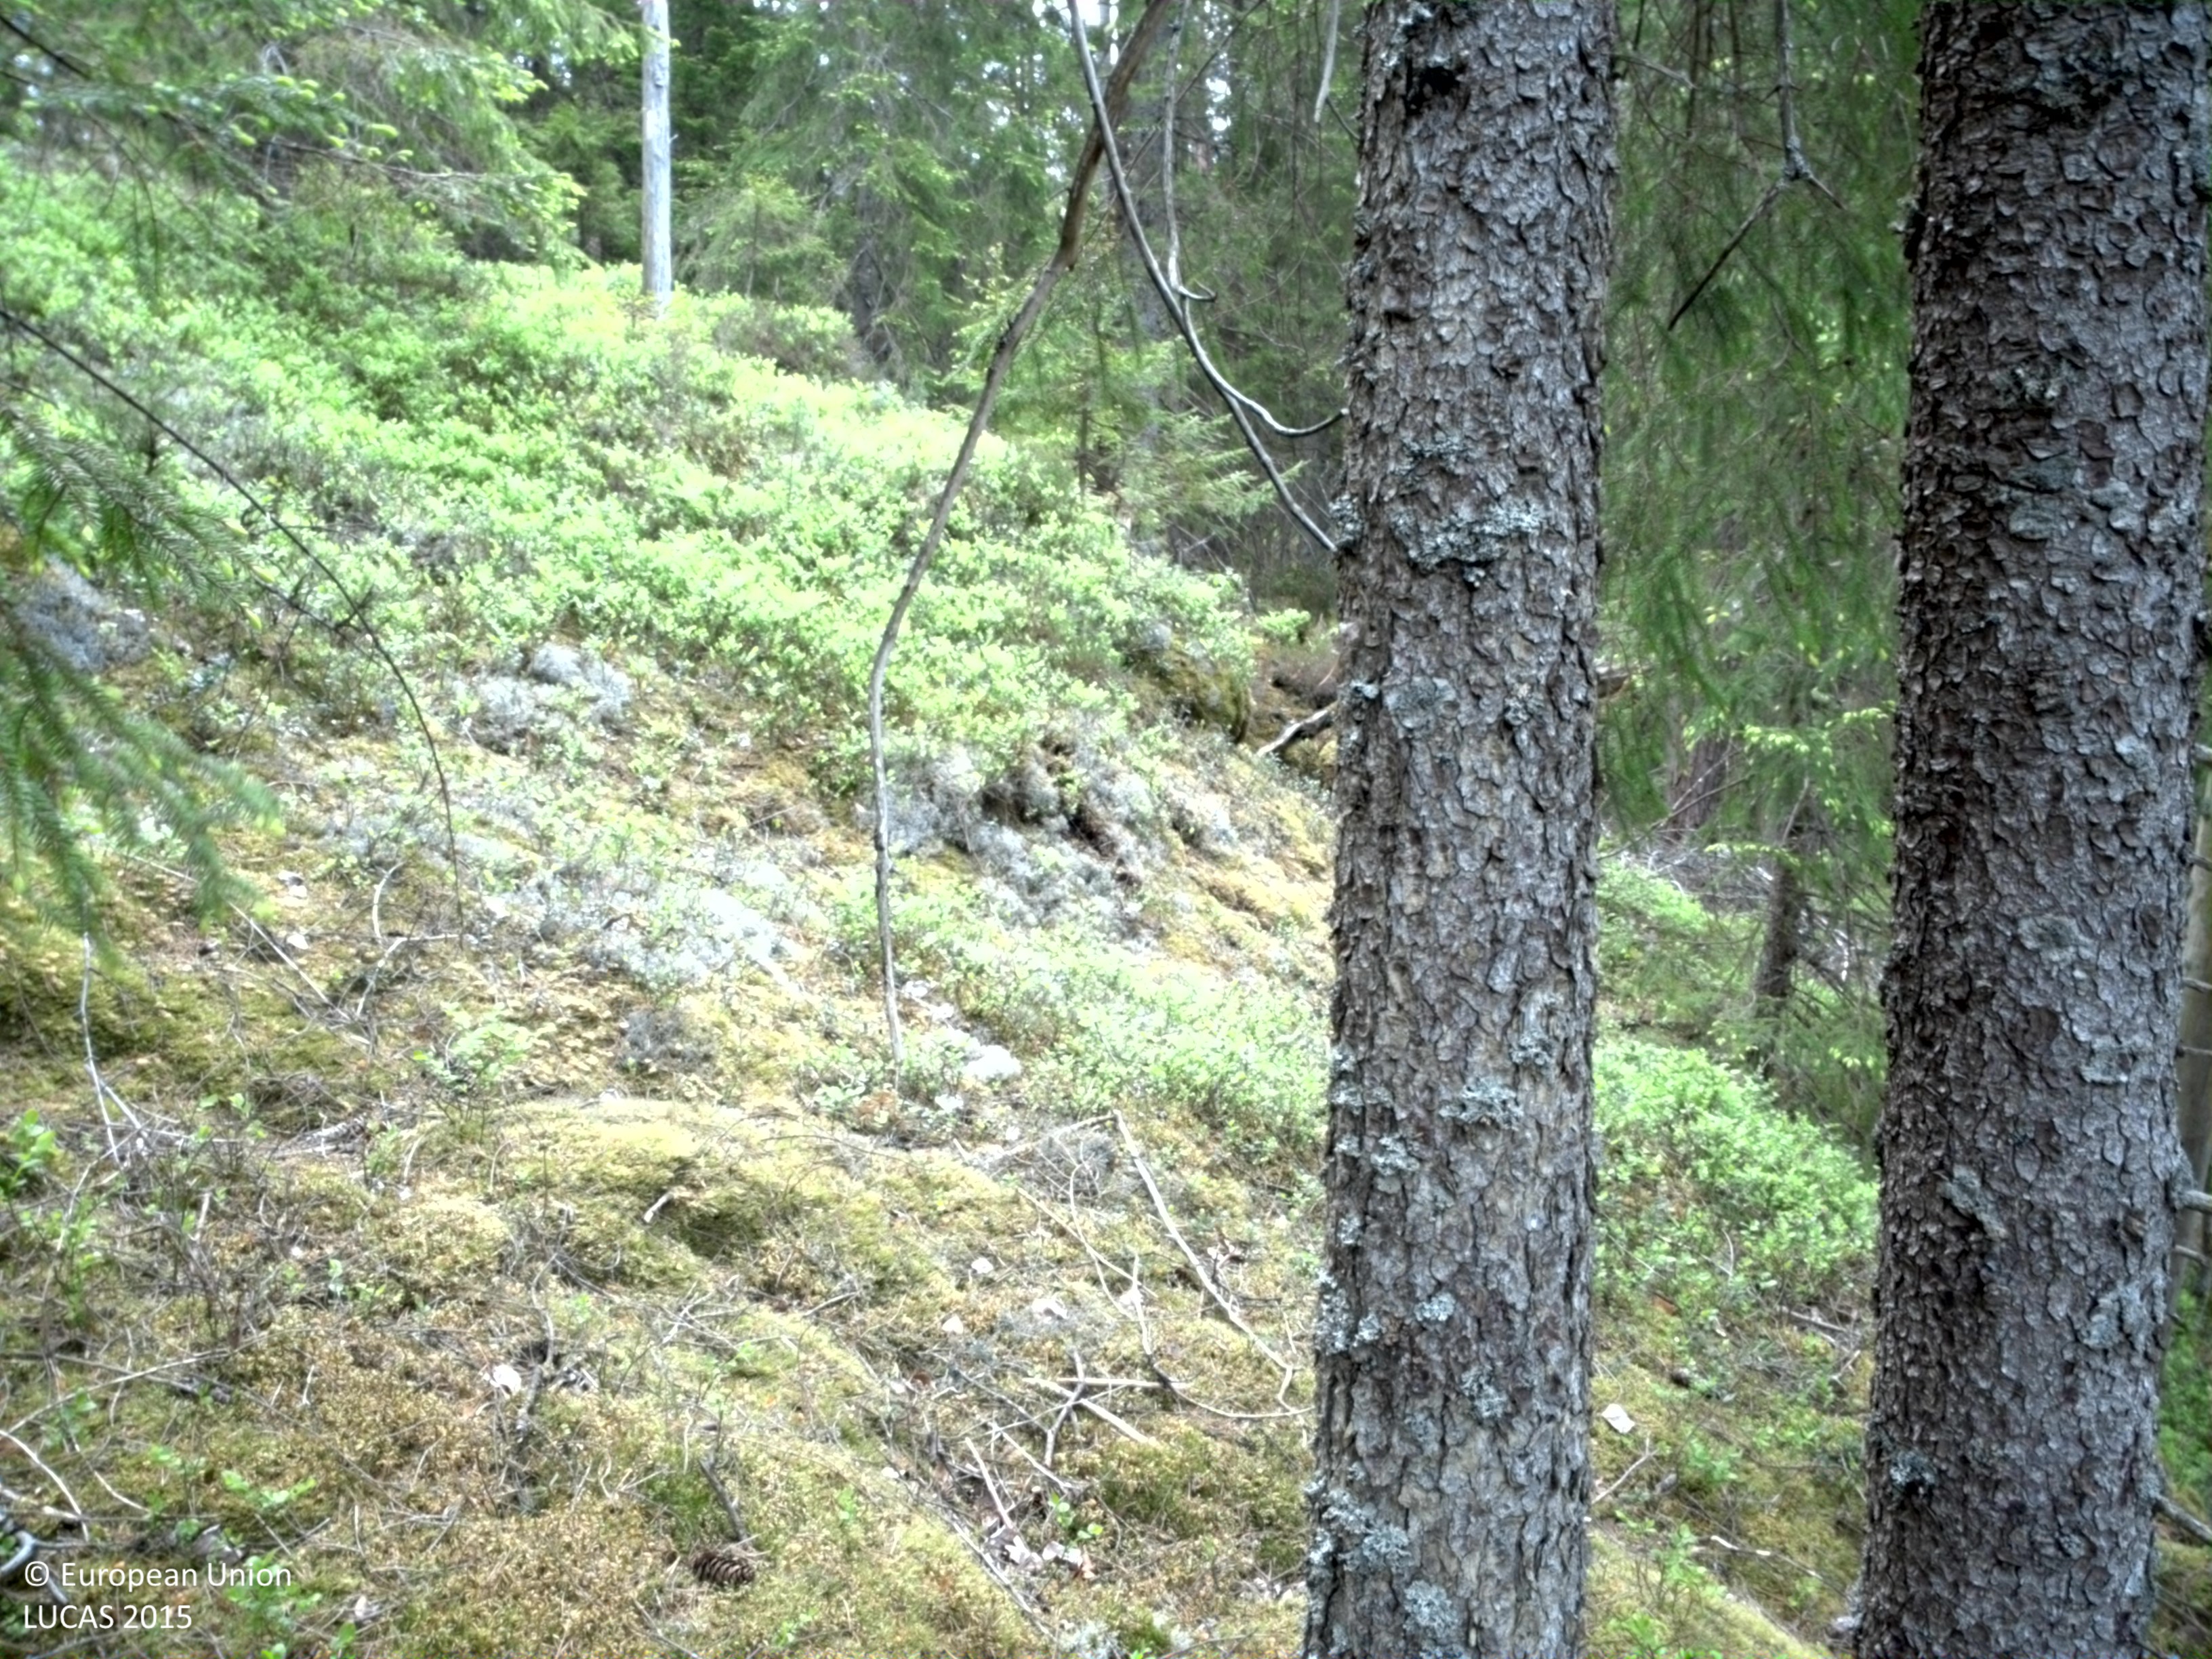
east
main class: Woodland
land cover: Spruce dominated coniferous woodland
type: boreal forest
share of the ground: 25 - 50 %
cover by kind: coniferous forest trees 45 %, shrubs 45 %, broadleaved forest trees 5 %, lichens and mosses 5 %
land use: Forestry
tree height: > 5 m
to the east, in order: Spruce dominated coniferous woodland; Shrubland with sparse tree cover; Spruce dominated coniferous woodland; Spruce dominated mixed woodland; Broadleaved woodland; Shrubland with sparse tree cover
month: June
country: SE
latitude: 57.4982
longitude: 13.8500
